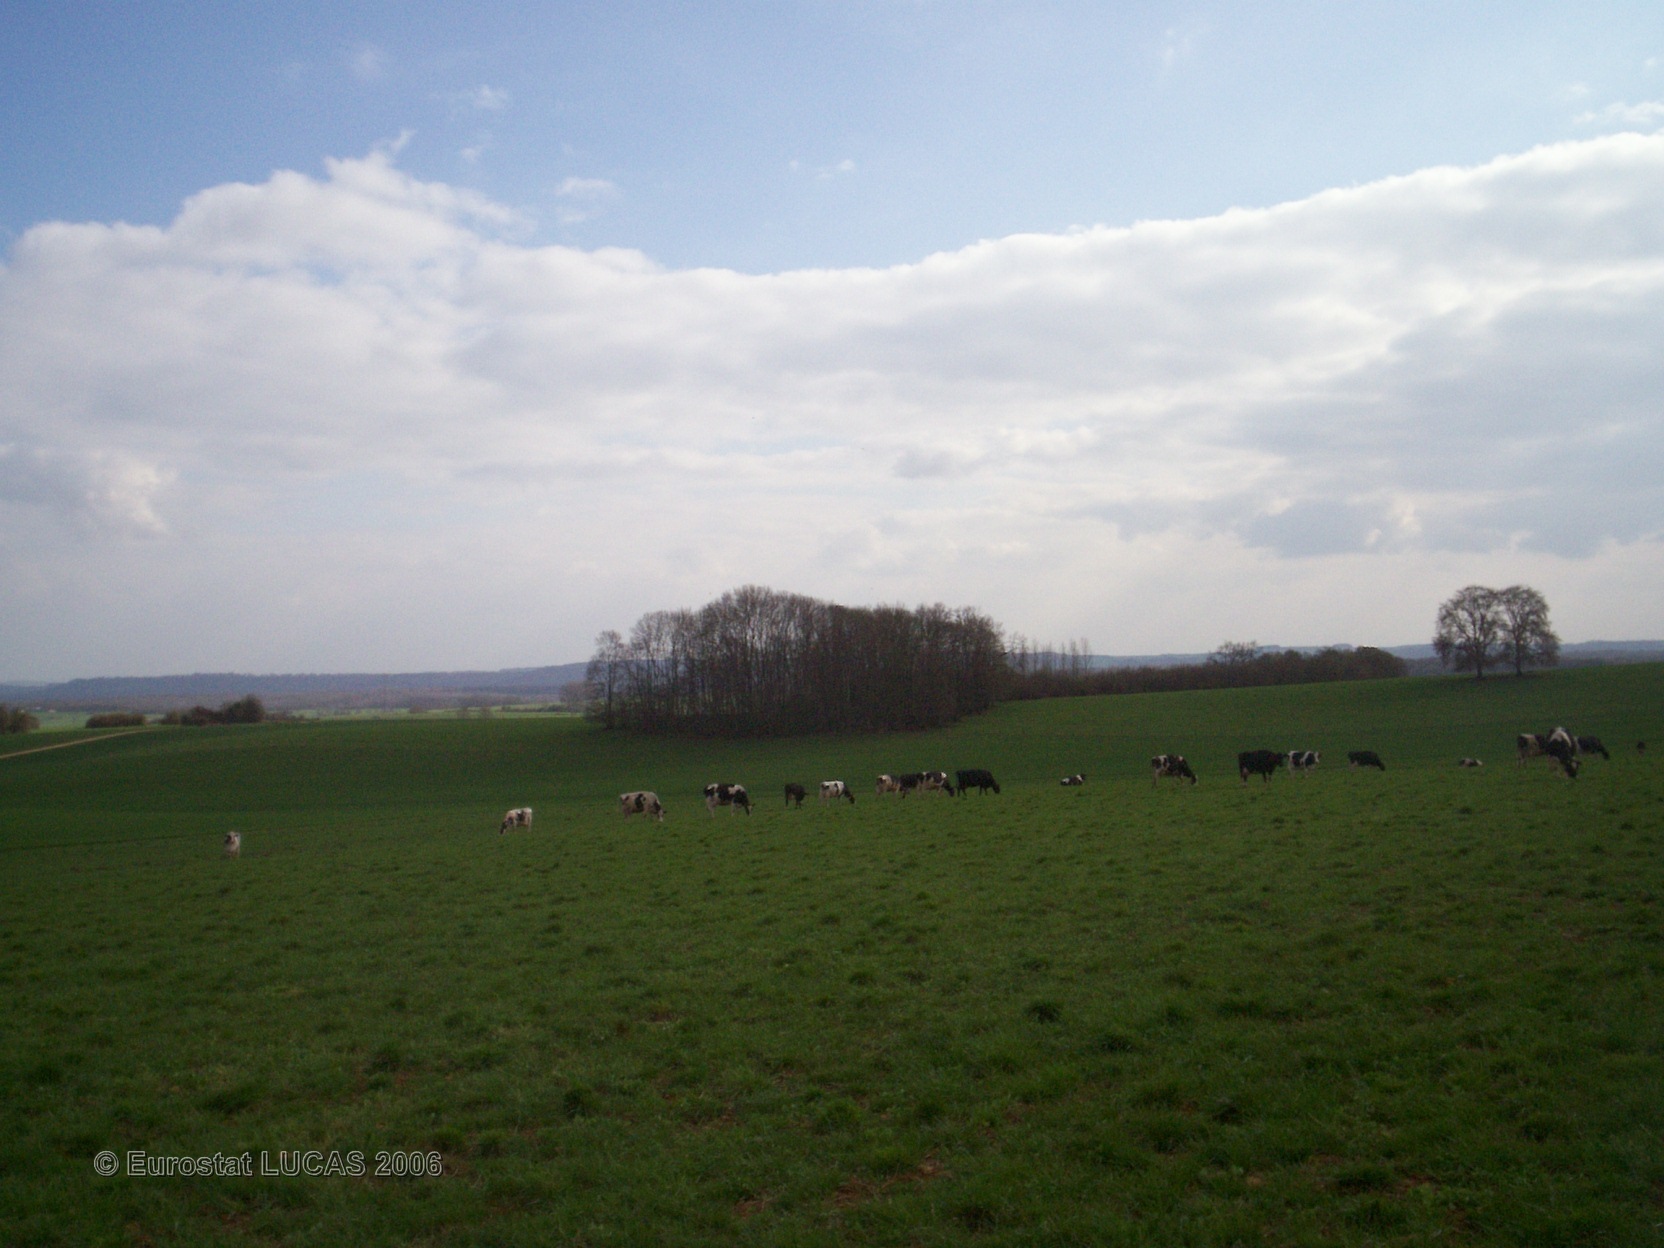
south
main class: Grassland
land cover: Grassland without tree/shrub cover
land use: Agriculture (excluding fallow land and kitchen gardens)
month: April
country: FR
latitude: 49.5536
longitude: 5.0351
